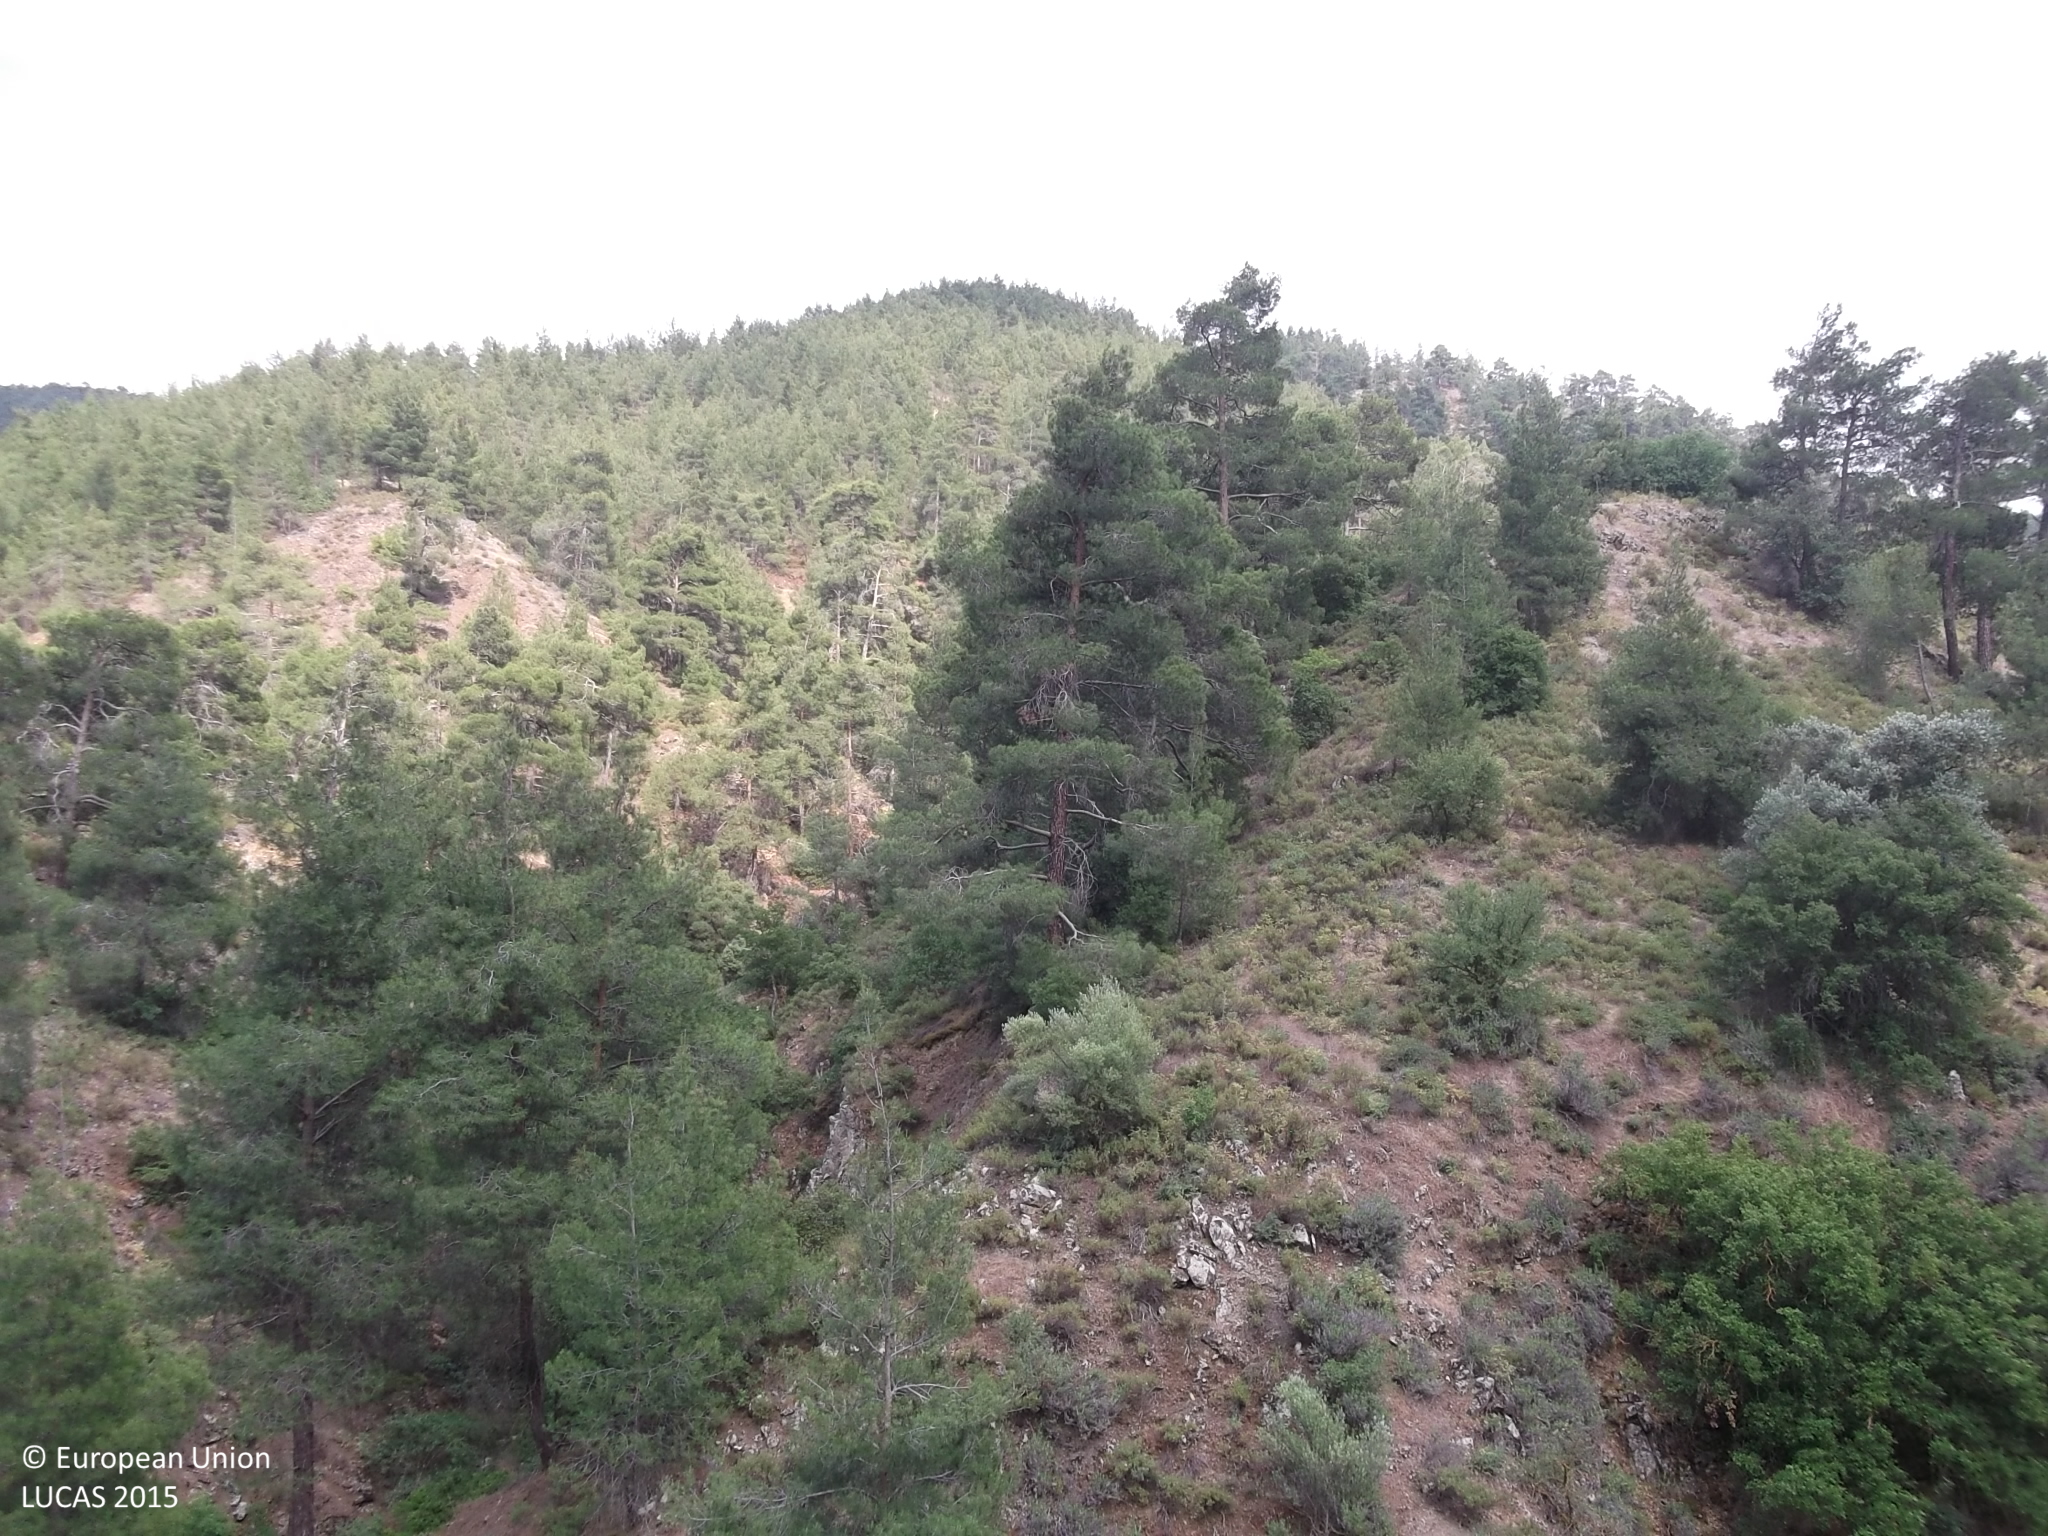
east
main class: Woodland
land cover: Pine dominated coniferous woodland
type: coniferous forest of the mediterranean region
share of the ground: 50 - 75 %
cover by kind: coniferous forest trees 60 %, shrubs 20 %, consolidated bare surface 10 %, unconsolidated bare surface 10 %
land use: Forestry
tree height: > 5 m
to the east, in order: Pine dominated coniferous woodland; Tracks; Pine dominated coniferous woodland
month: June
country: CY
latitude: 35.0010
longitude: 32.9970
